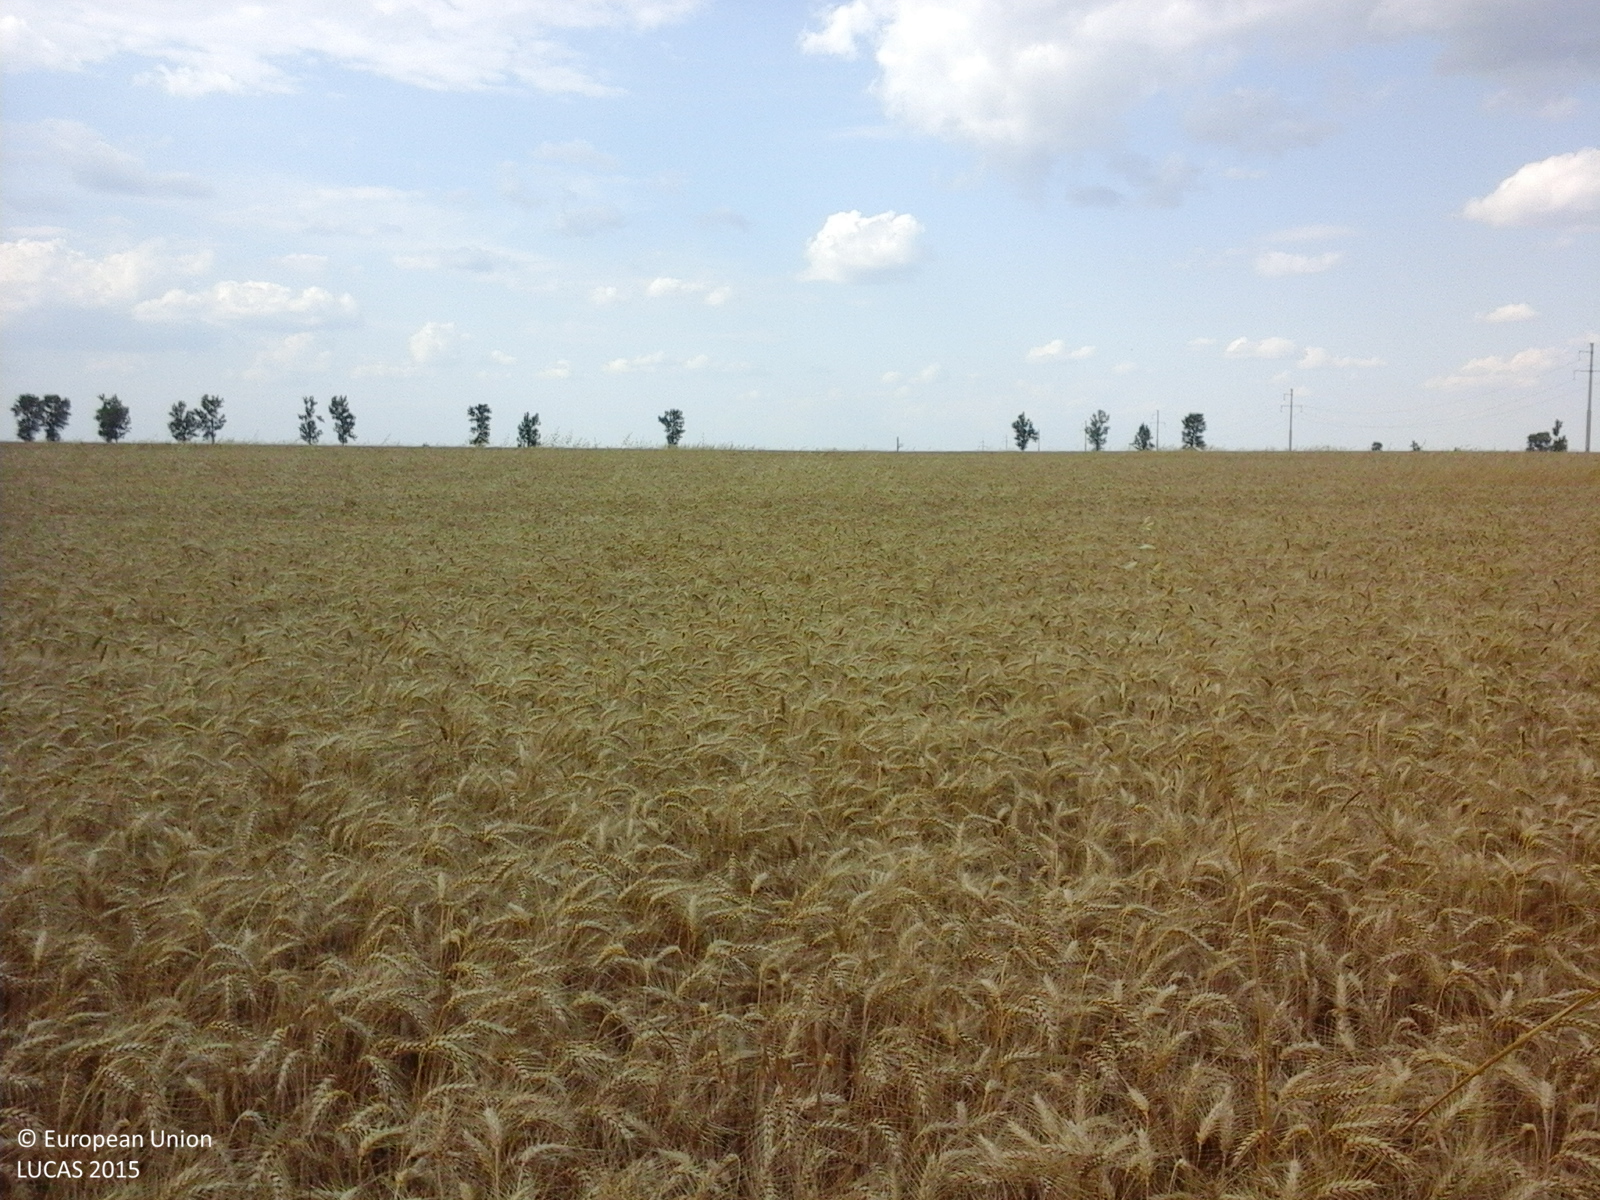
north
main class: Cropland
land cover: Common wheat
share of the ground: > 75 %
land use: Agriculture (excluding fallow land and kitchen gardens)
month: June
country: RO
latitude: 44.1693
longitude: 26.2006
